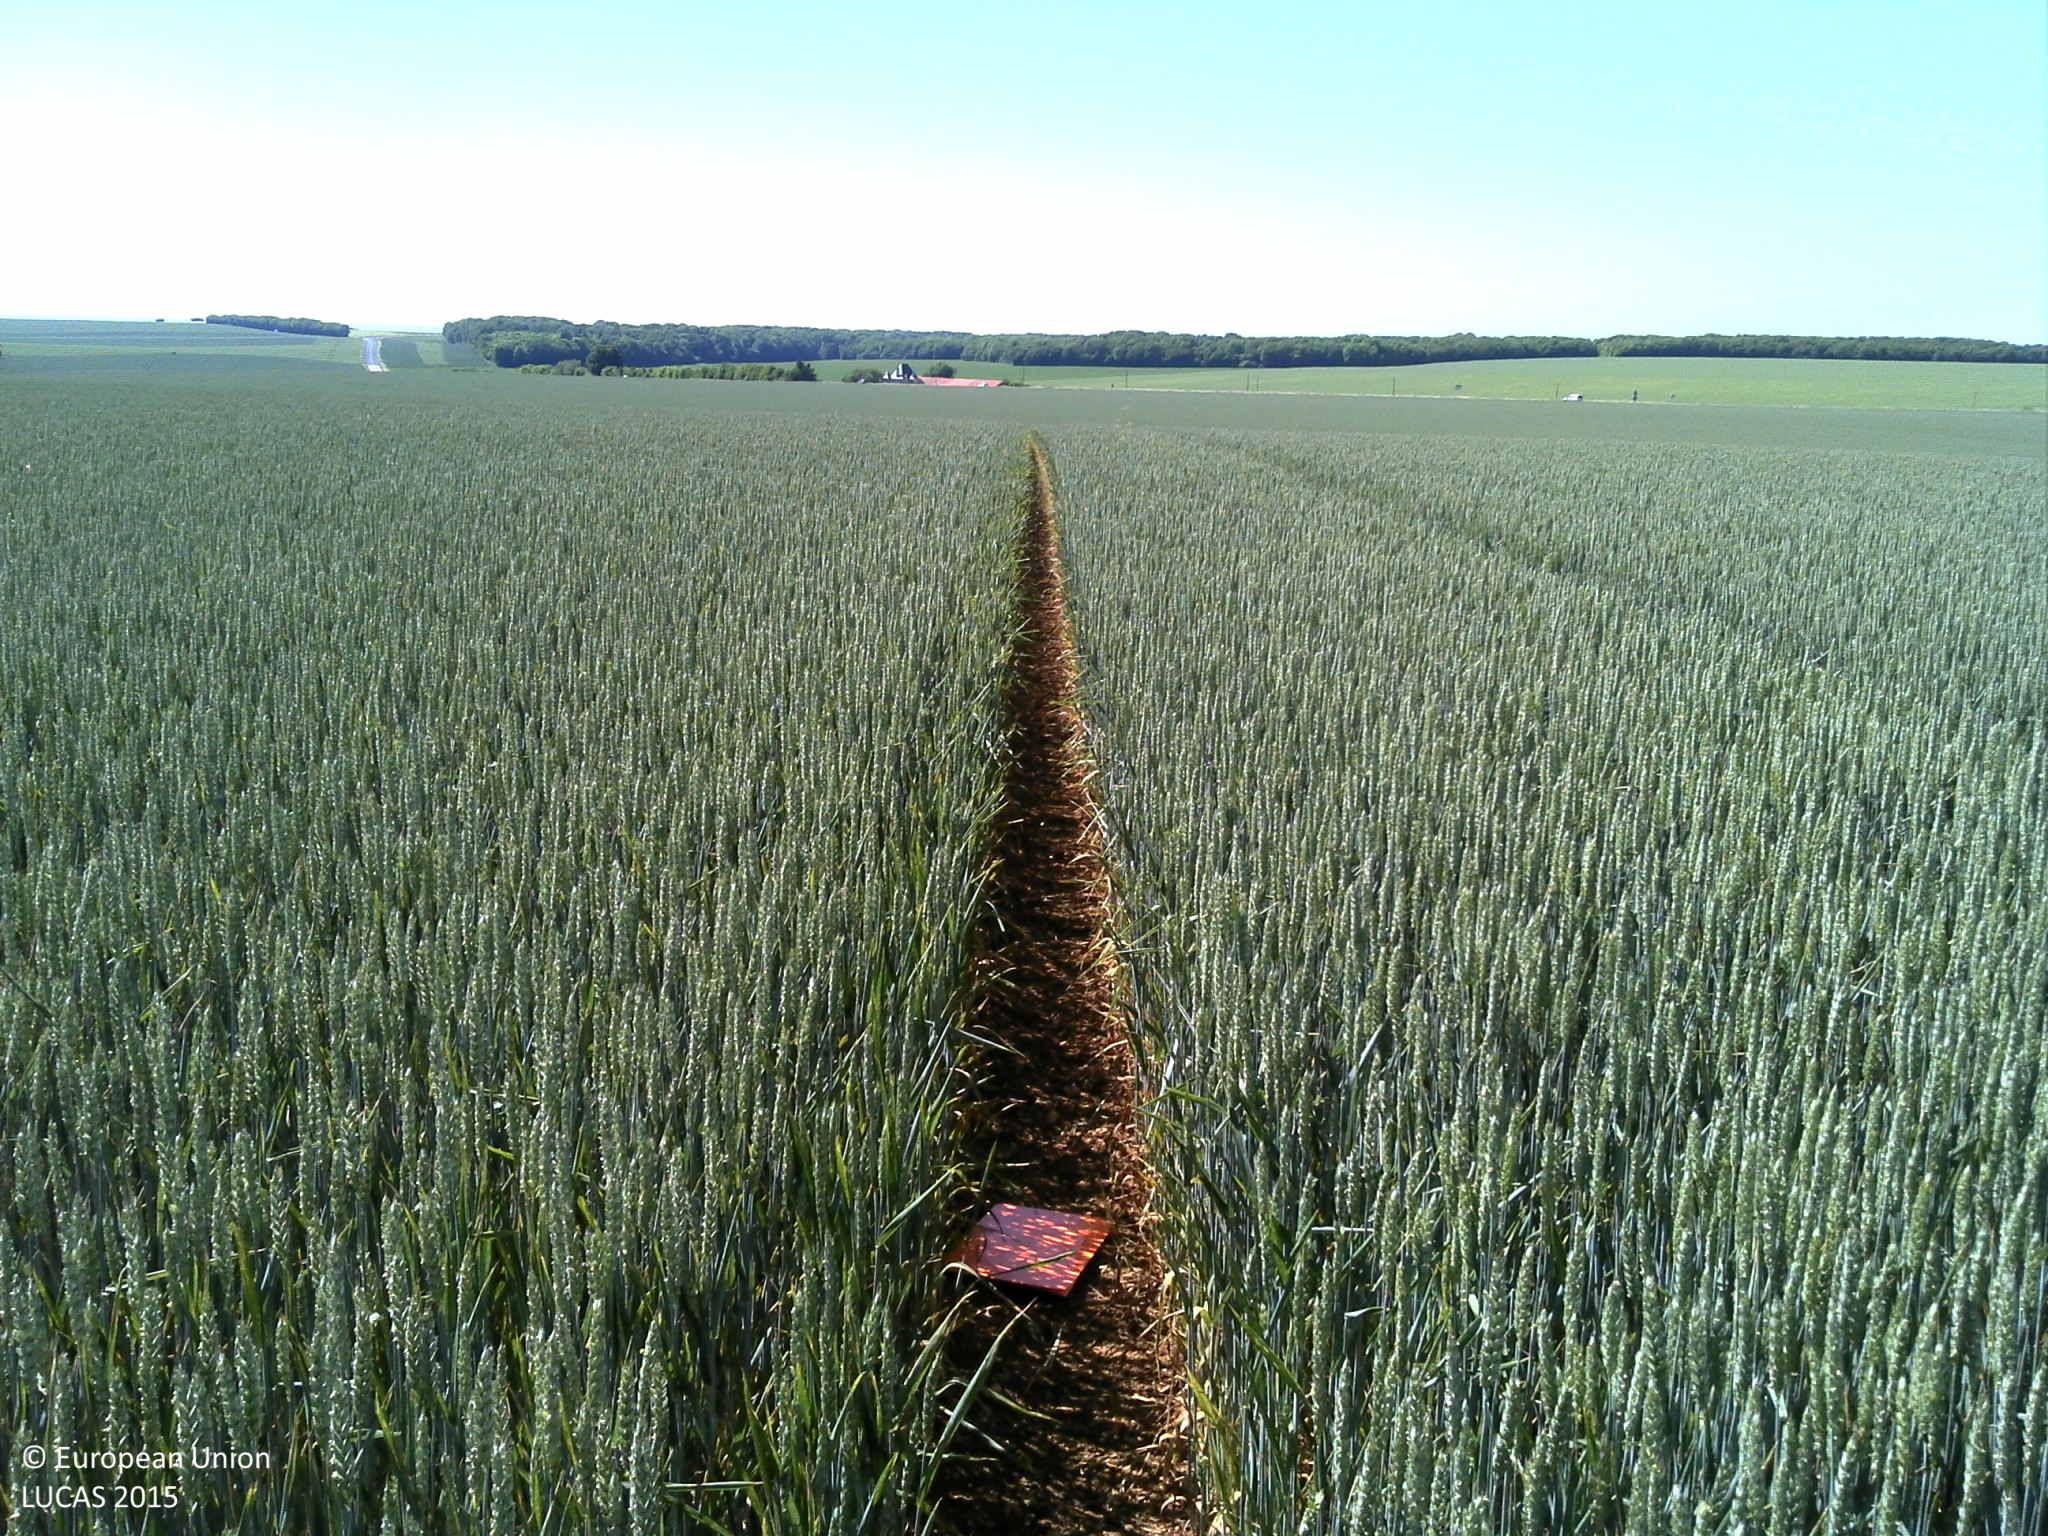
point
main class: Cropland
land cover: Common wheat
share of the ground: > 75 %
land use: Agriculture (excluding fallow land and kitchen gardens)
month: June
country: FR
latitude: 49.1241
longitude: 6.0119
